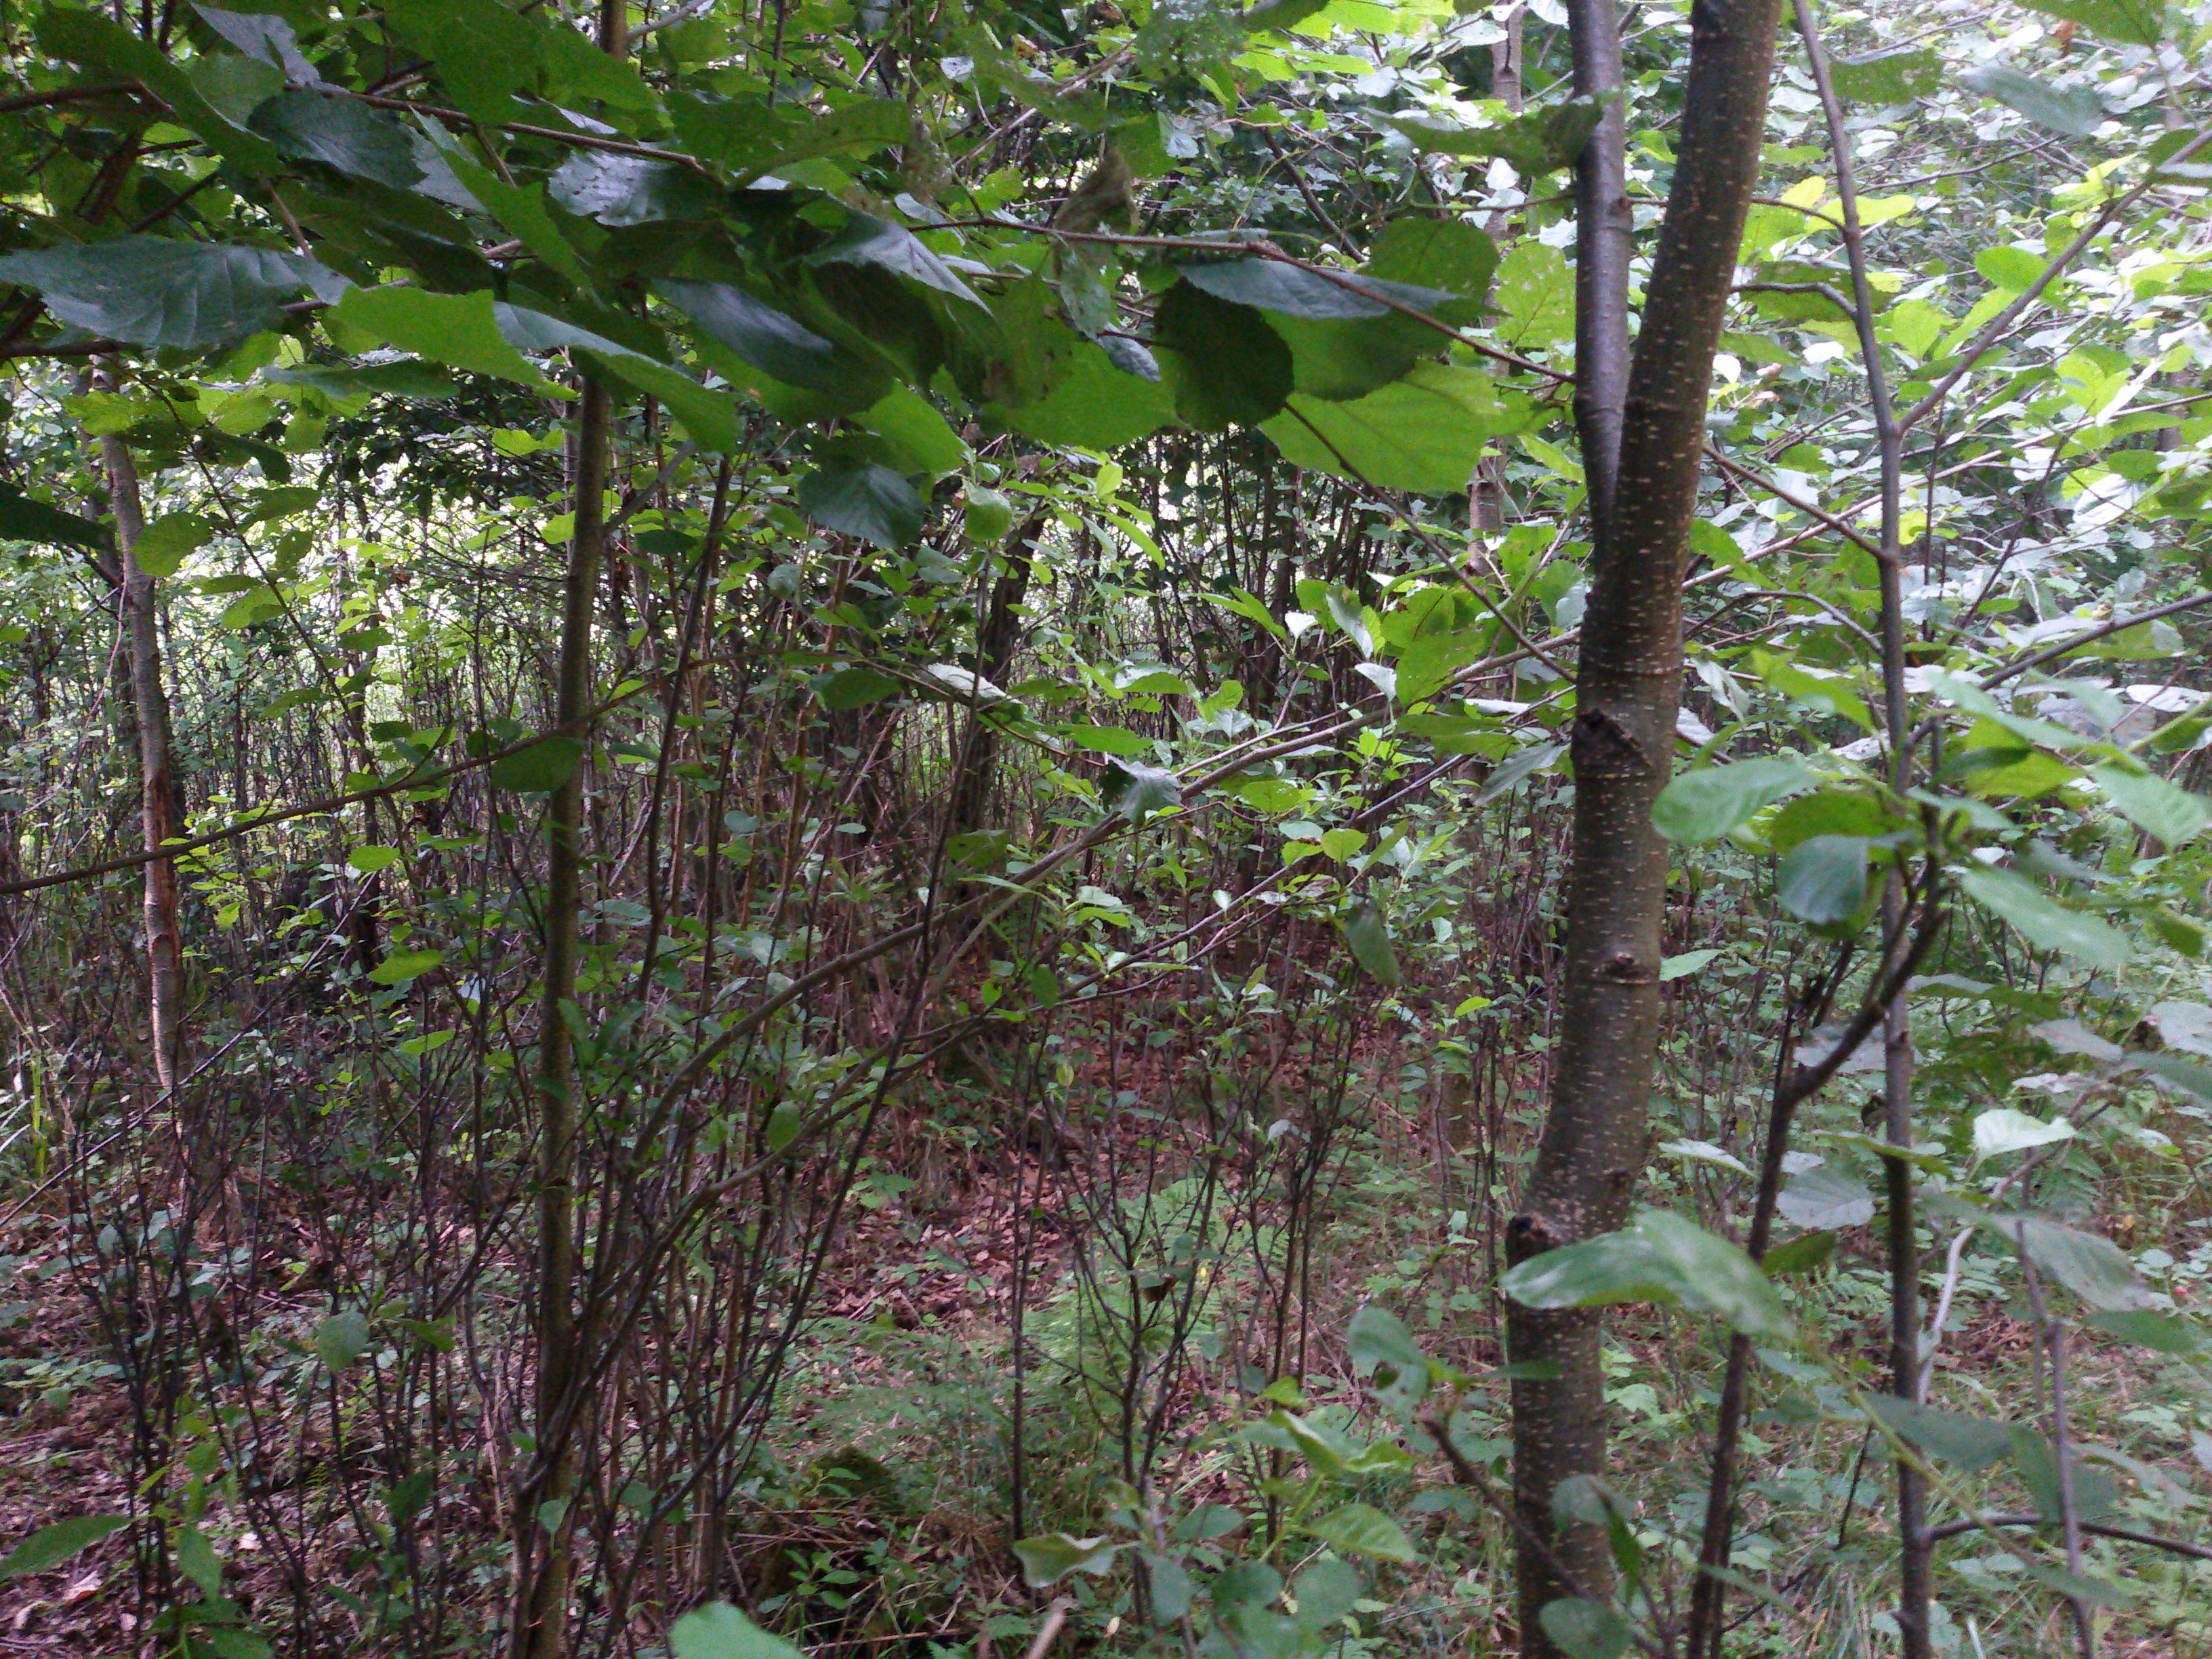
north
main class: Woodland
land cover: Broadleaved woodland
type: mesophytic deciduous forest
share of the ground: > 75 %
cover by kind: broadleaved forest trees 95 %, shrubs 5 %
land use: Semi-natural and natural areas not in use
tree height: < 5 m
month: August
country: PL
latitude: 53.3032
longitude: 16.0828
